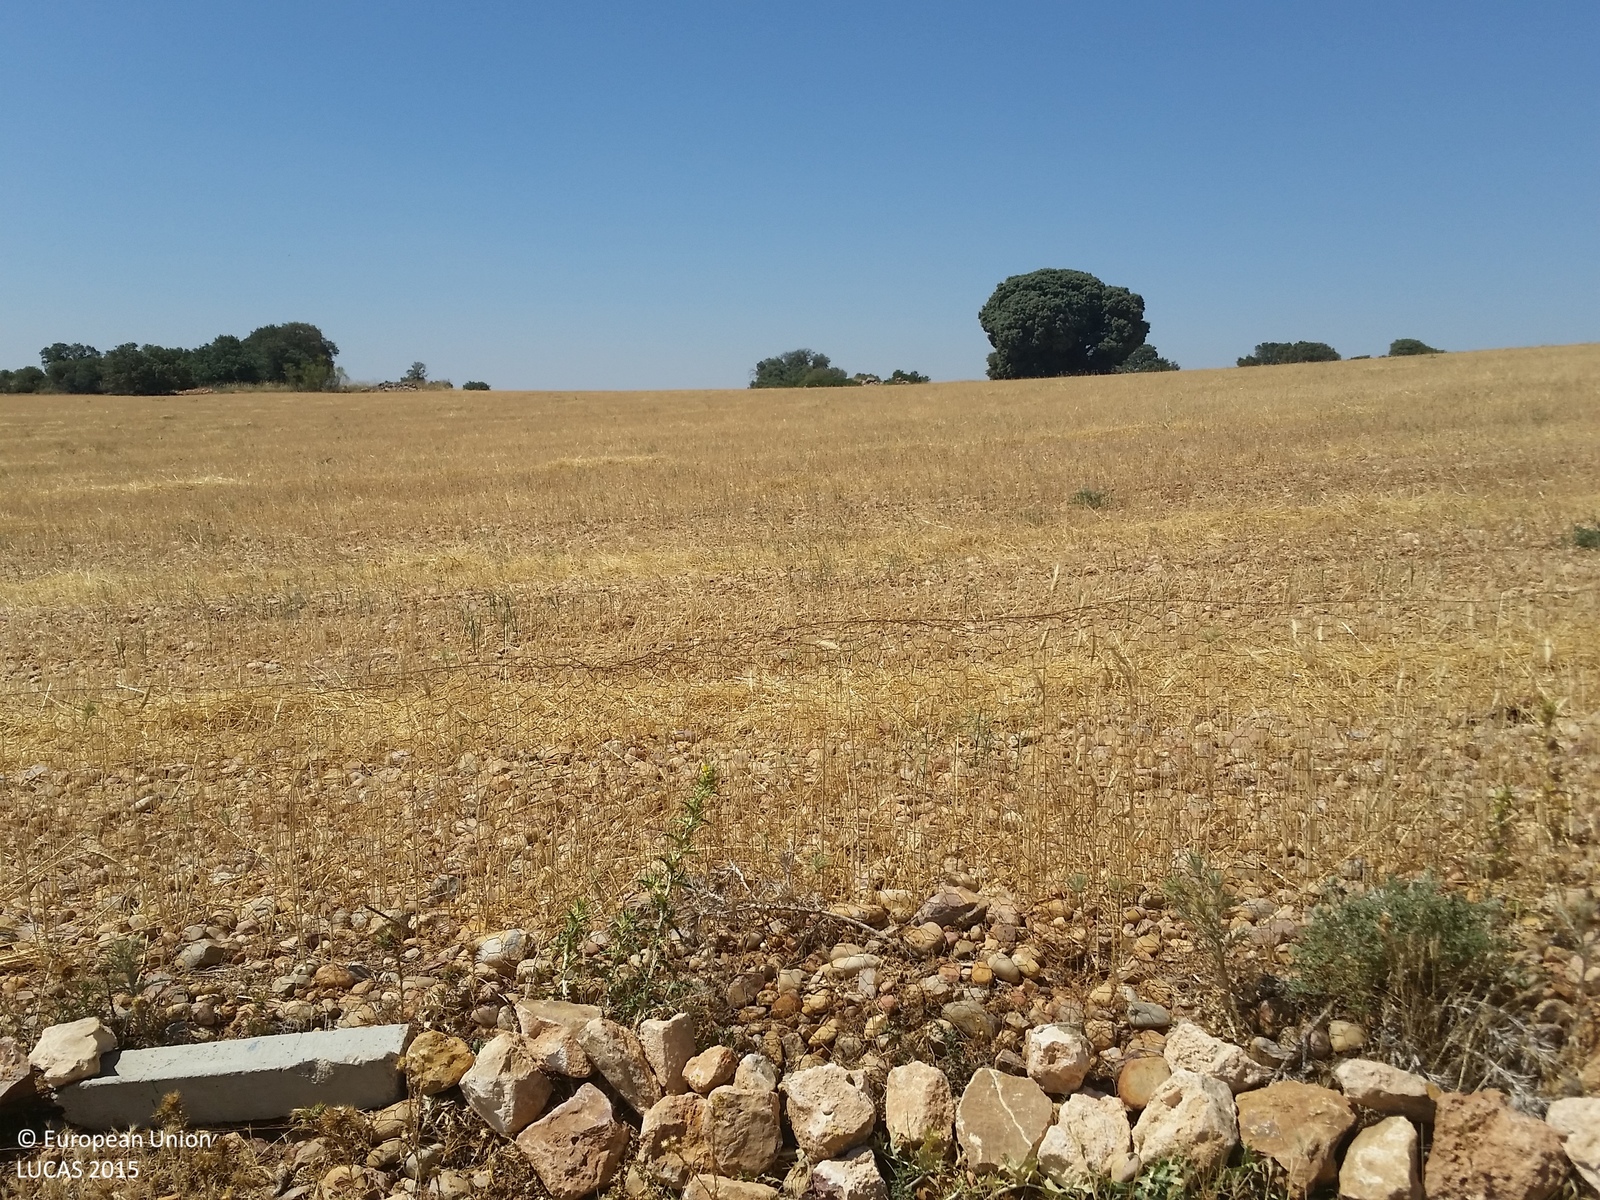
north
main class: Cropland
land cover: Vineyards
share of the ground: 50 - 75 %
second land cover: Other bare soil
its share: > 75 %
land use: Agriculture (excluding fallow land and kitchen gardens)
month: July
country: ES
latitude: 39.1335
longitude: -2.5130
